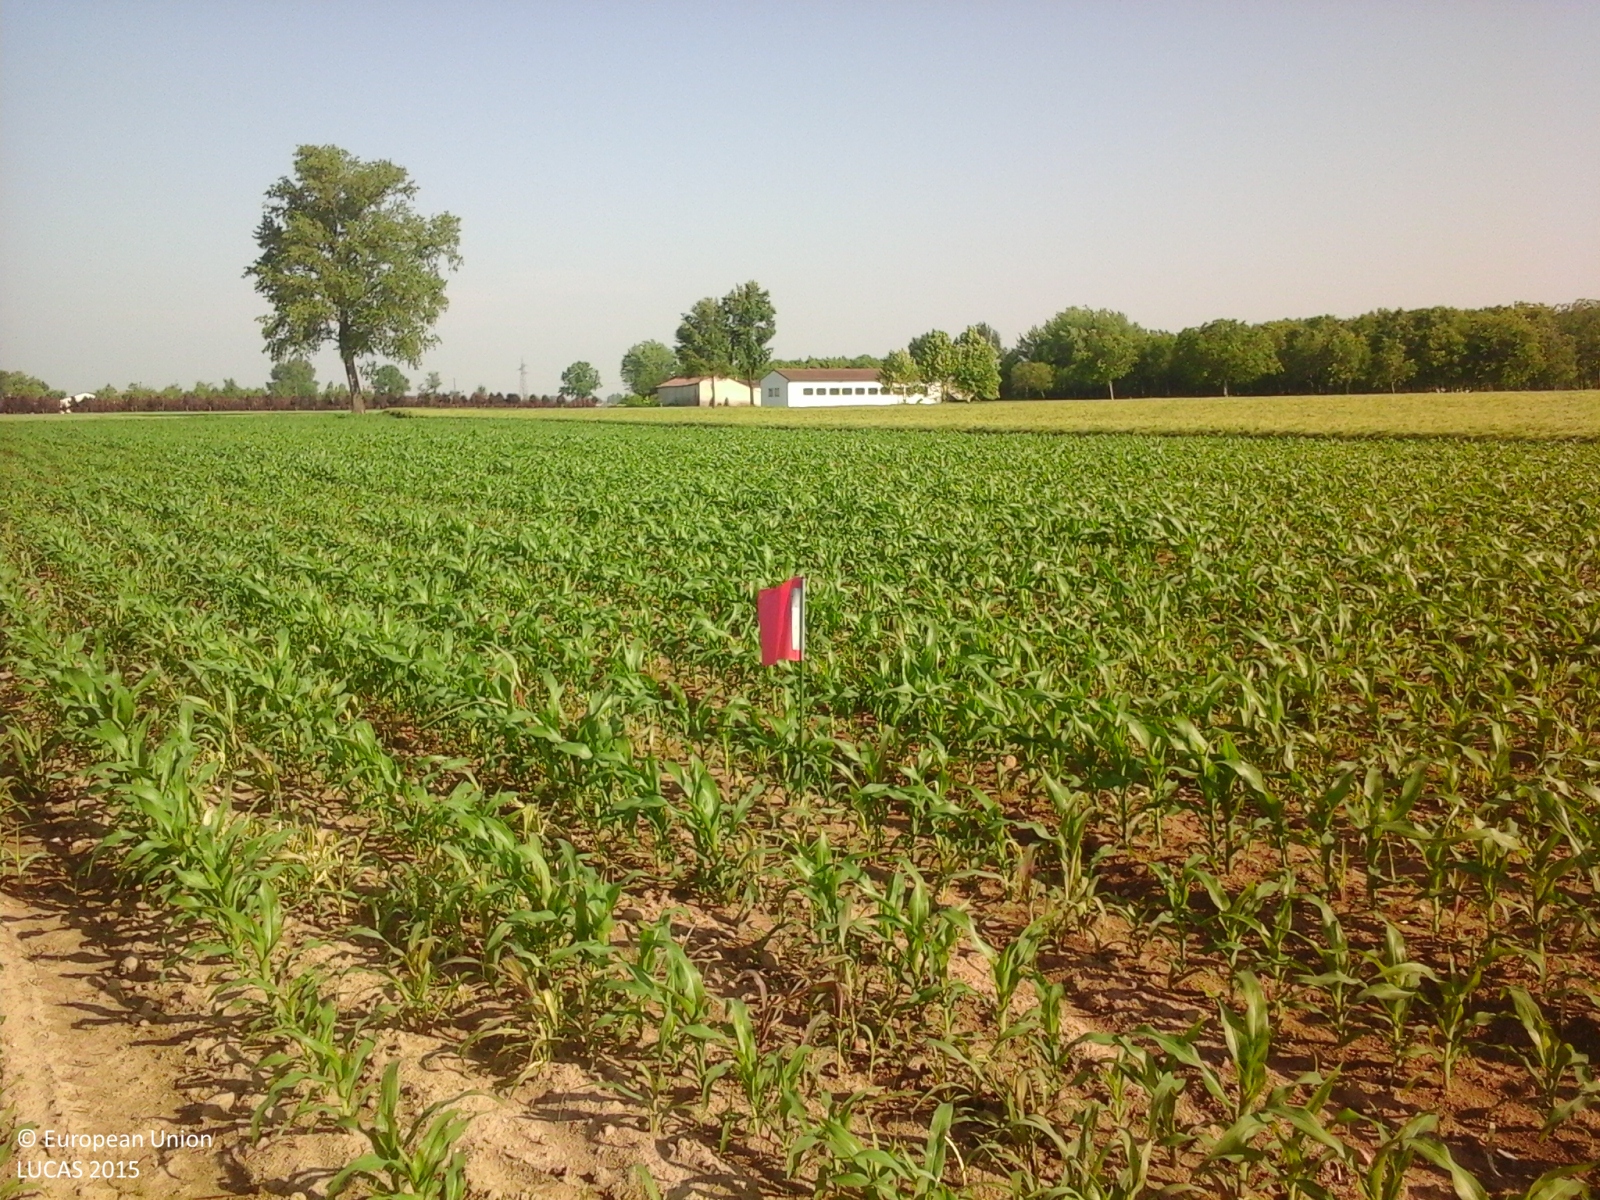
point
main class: Cropland
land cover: Maize
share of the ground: 25 - 50 %
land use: Agriculture (excluding fallow land and kitchen gardens)
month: May
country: IT
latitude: 45.1240
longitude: 10.6218
